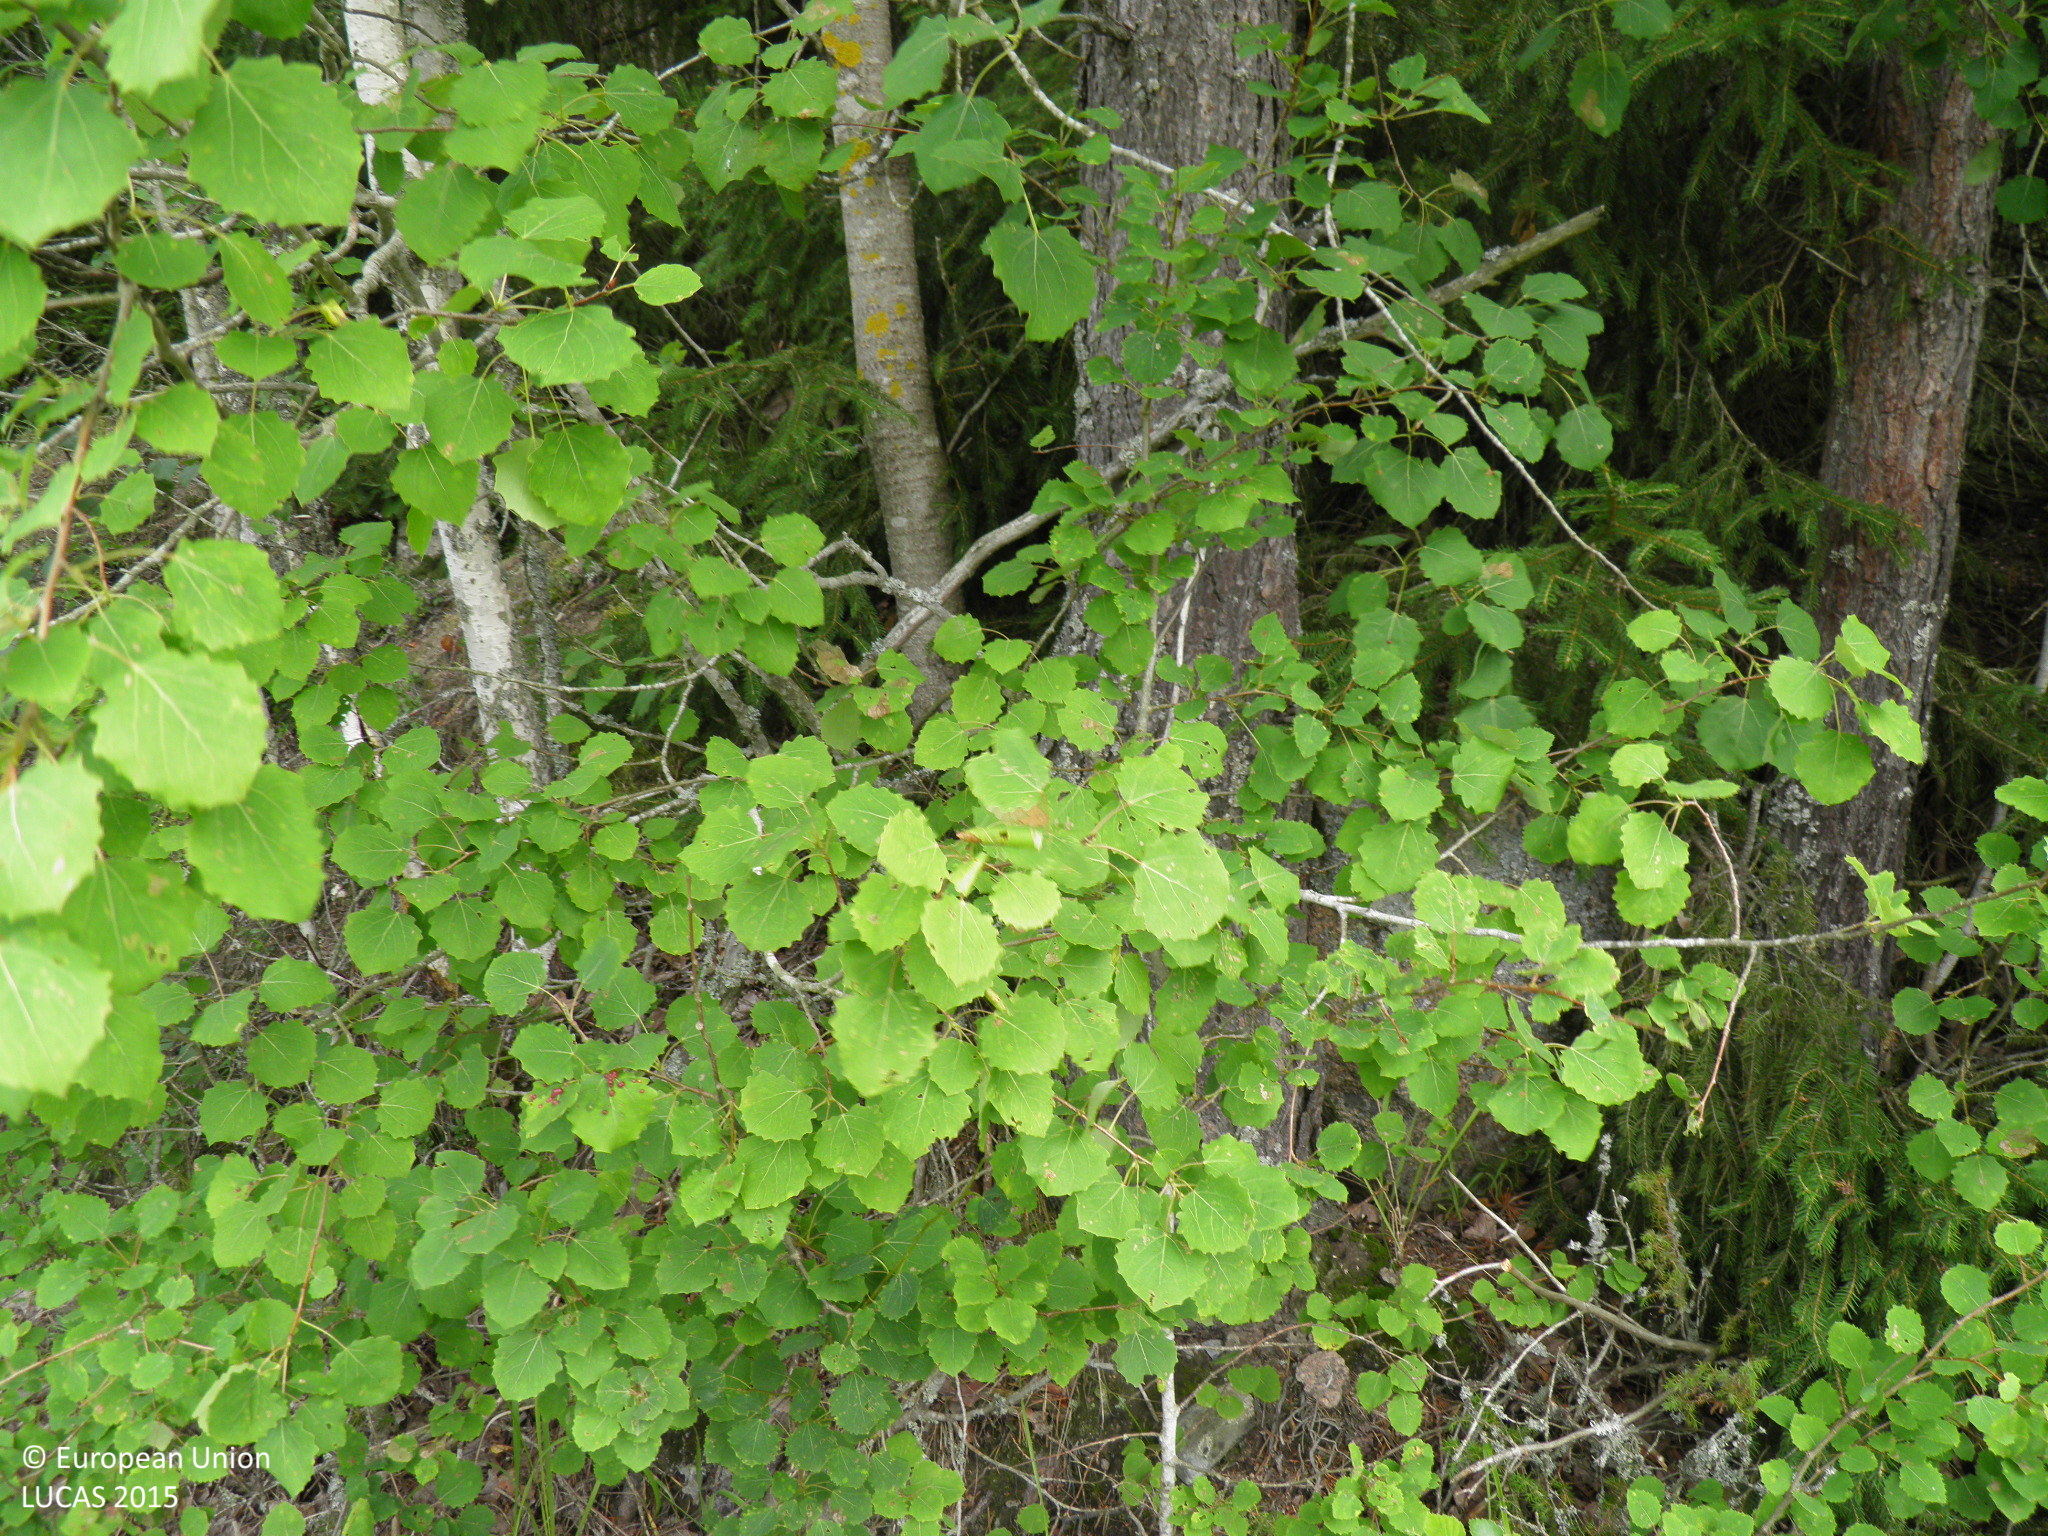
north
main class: Cropland
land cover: Barley
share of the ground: > 75 %
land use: Agriculture (excluding fallow land and kitchen gardens)
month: July
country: FI
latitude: 60.7044
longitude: 21.5803
